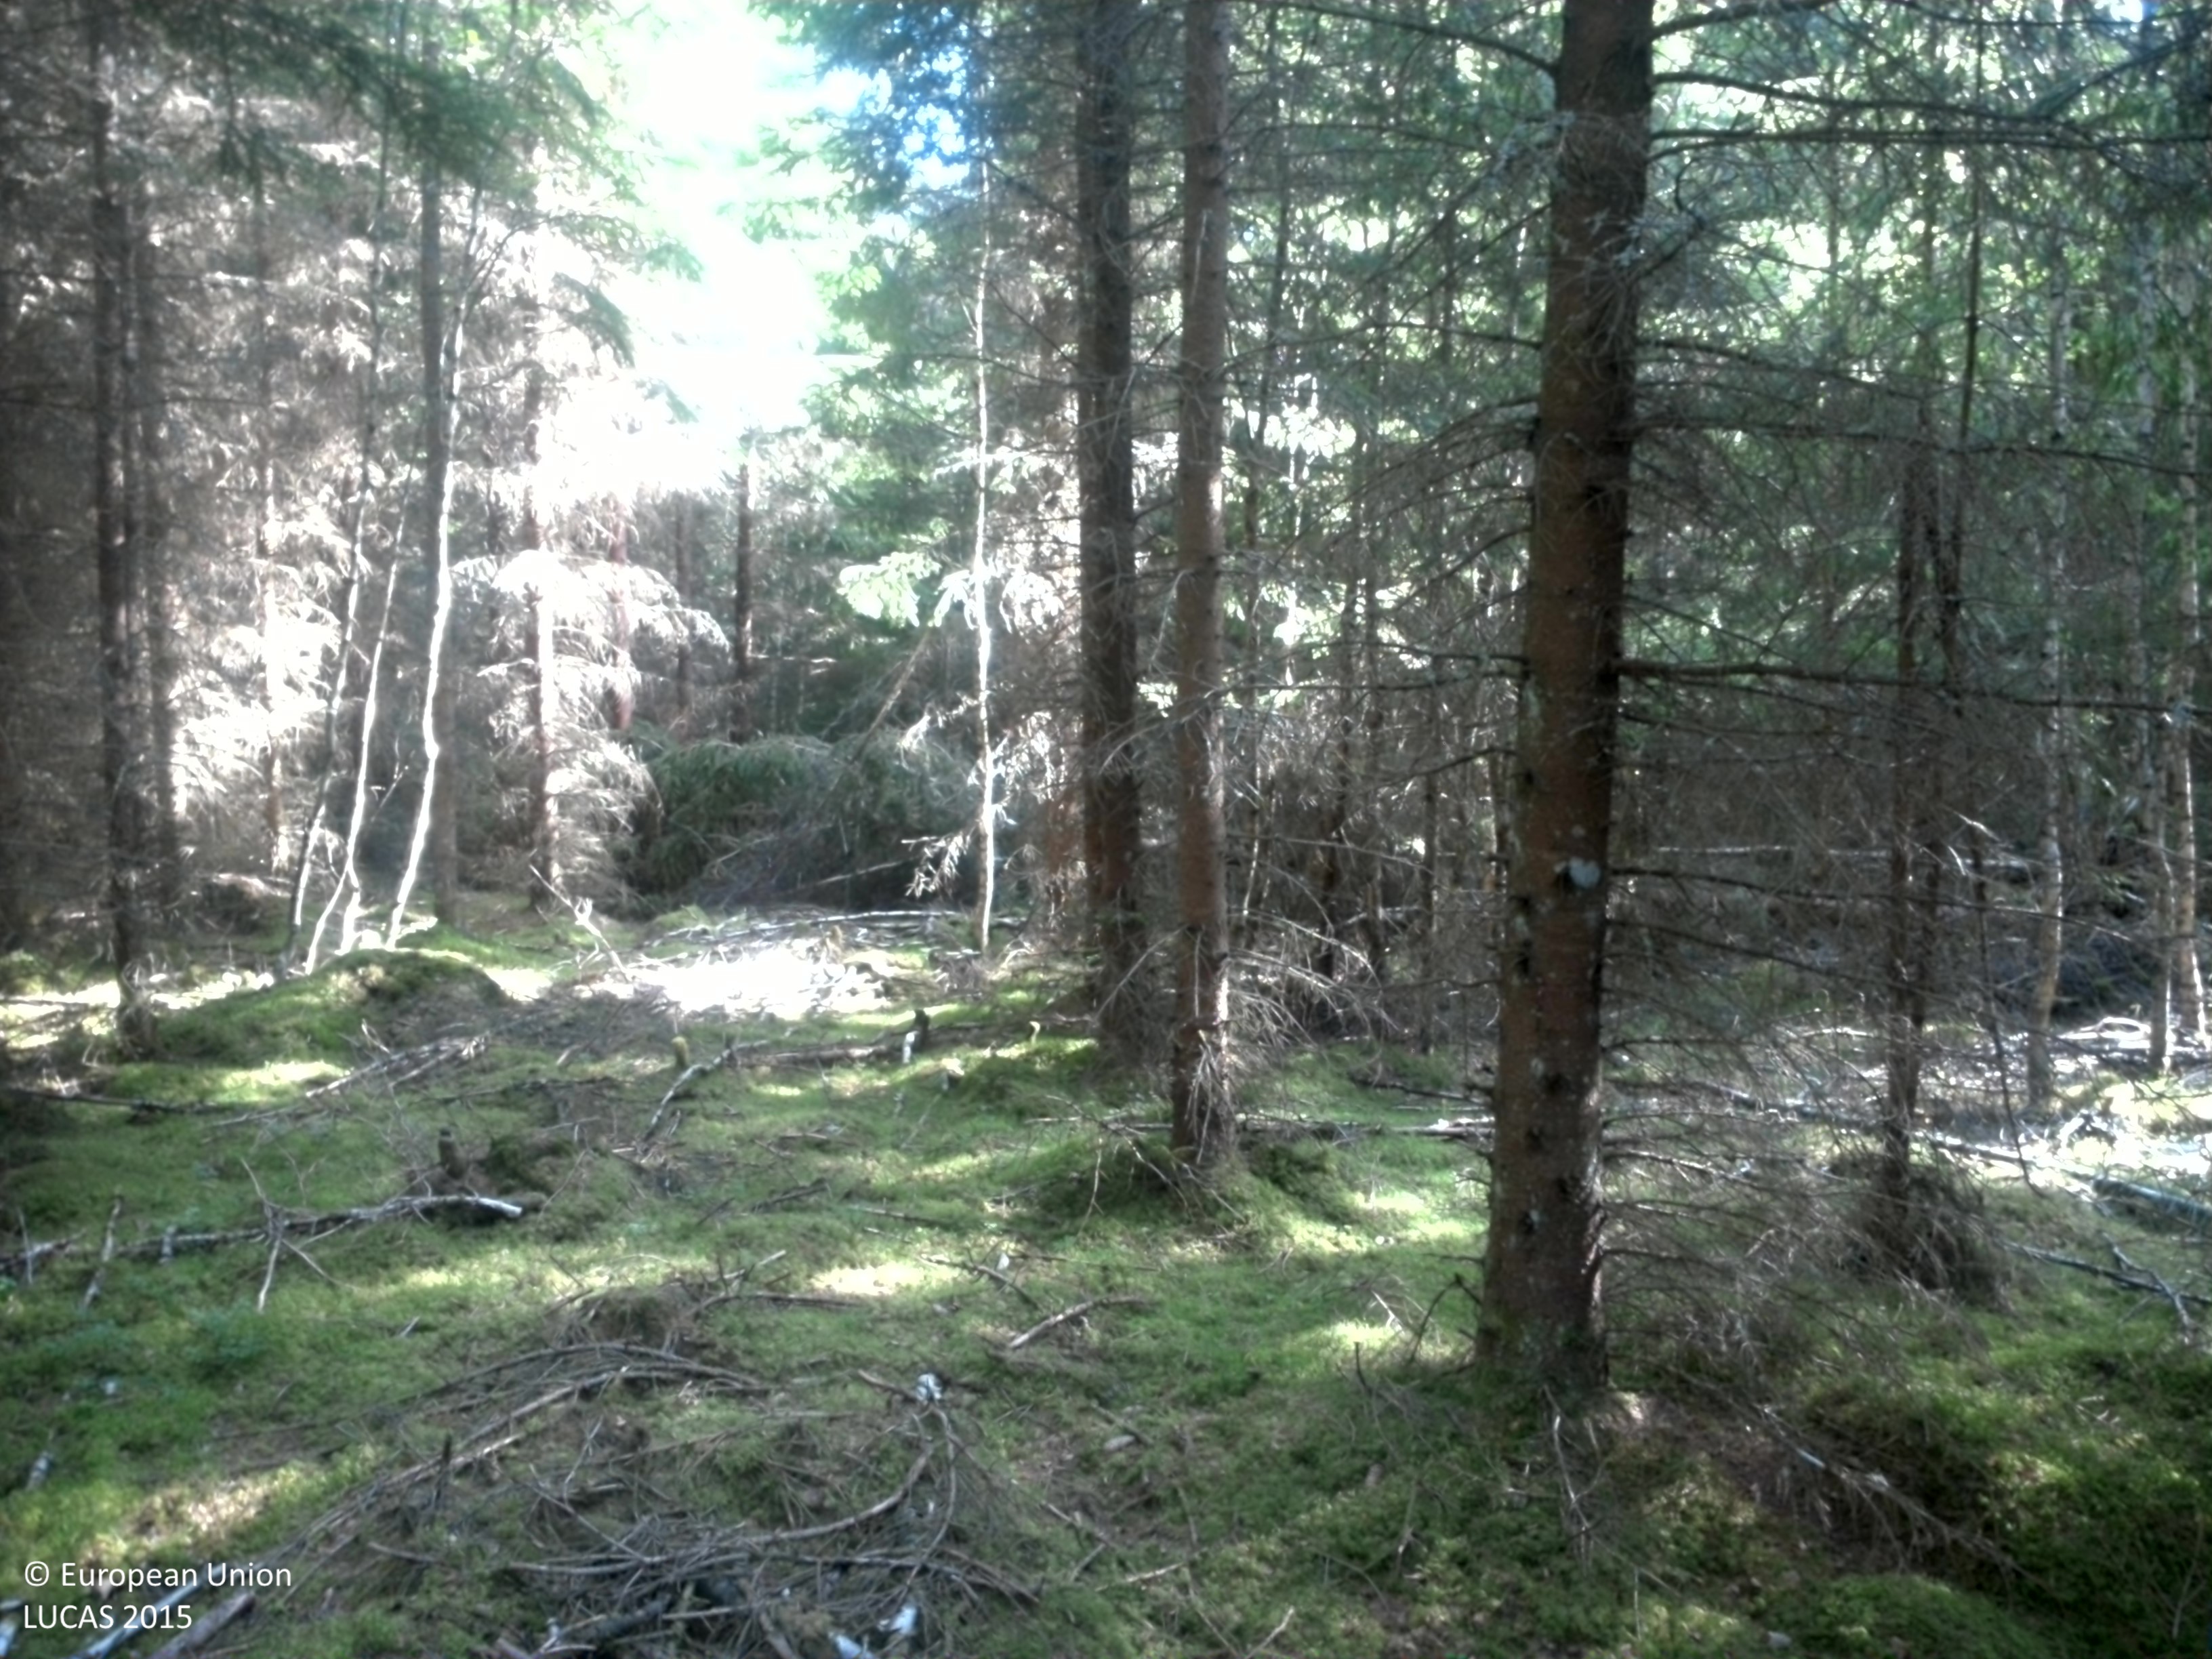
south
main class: Woodland
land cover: Spruce dominated coniferous woodland
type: boreal forest
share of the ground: 50 - 75 %
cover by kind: coniferous forest trees 70 %, lichens and mosses 25 %, herbaceous plants 5 %
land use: Forestry
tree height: > 5 m
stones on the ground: < 10 %
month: August
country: SE
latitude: 58.1608
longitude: 13.3087
